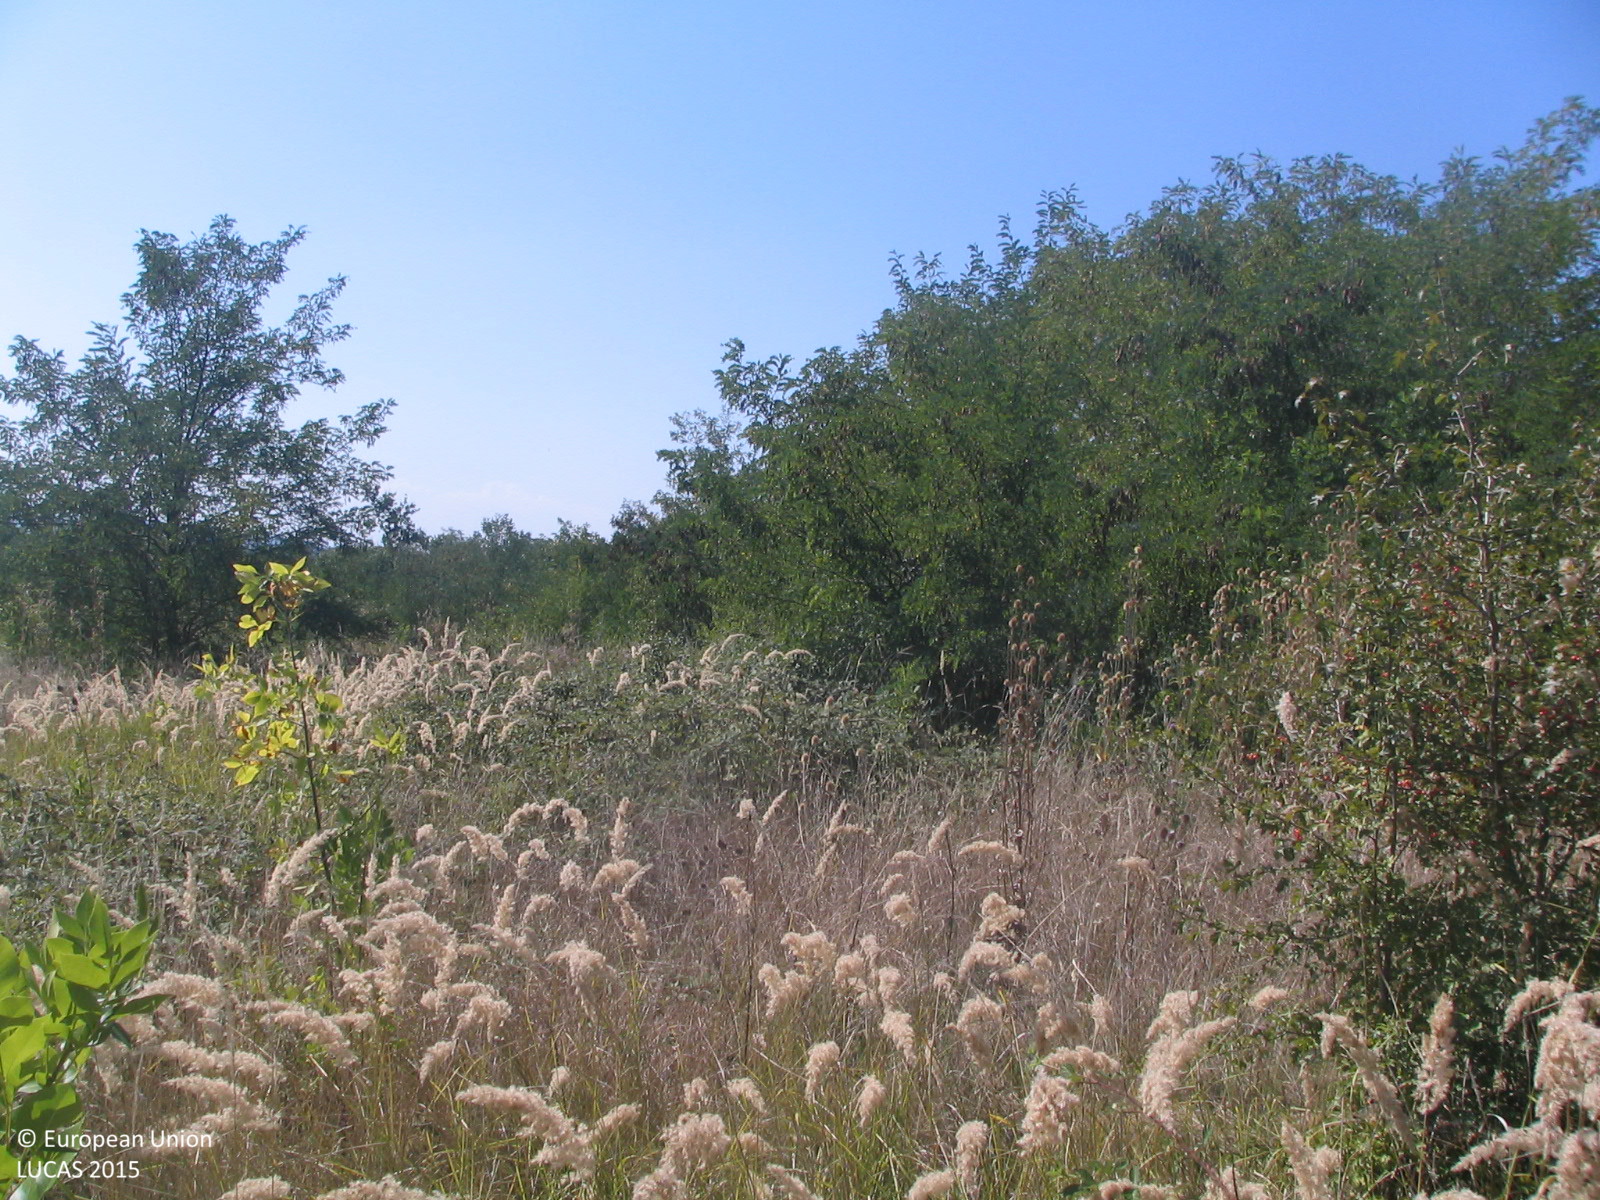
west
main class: Woodland
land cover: Broadleaved woodland
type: mesophytic deciduous forest
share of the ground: 25 - 50 %
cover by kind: herbaceous plants 40 %, broadleaved forest trees 30 %, shrubs 30 %
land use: Semi-natural and natural areas not in use
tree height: > 5 m
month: September
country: BG
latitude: 43.1308
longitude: 24.3267
